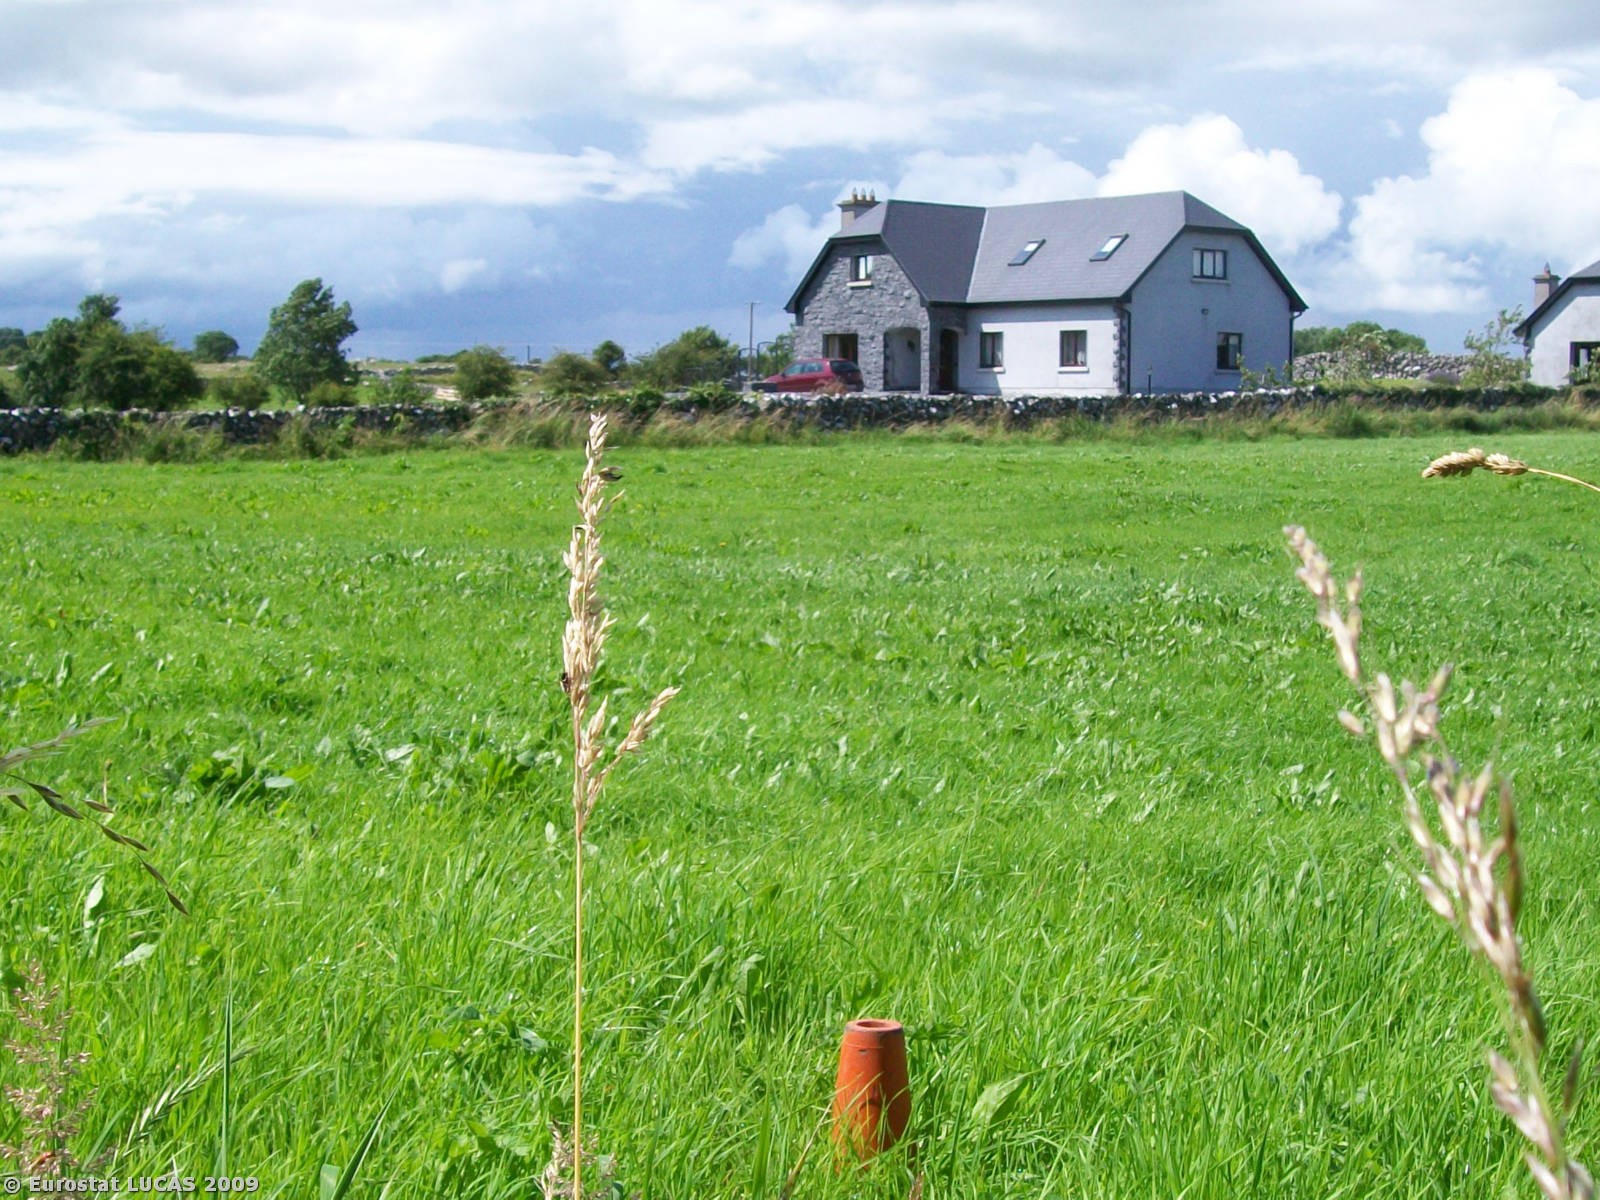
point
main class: Grassland
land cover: Grassland without tree/shrub cover
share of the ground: > 75 %
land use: Agriculture (excluding fallow land and kitchen gardens)
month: July
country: IE
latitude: 53.1811
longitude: -8.7112
